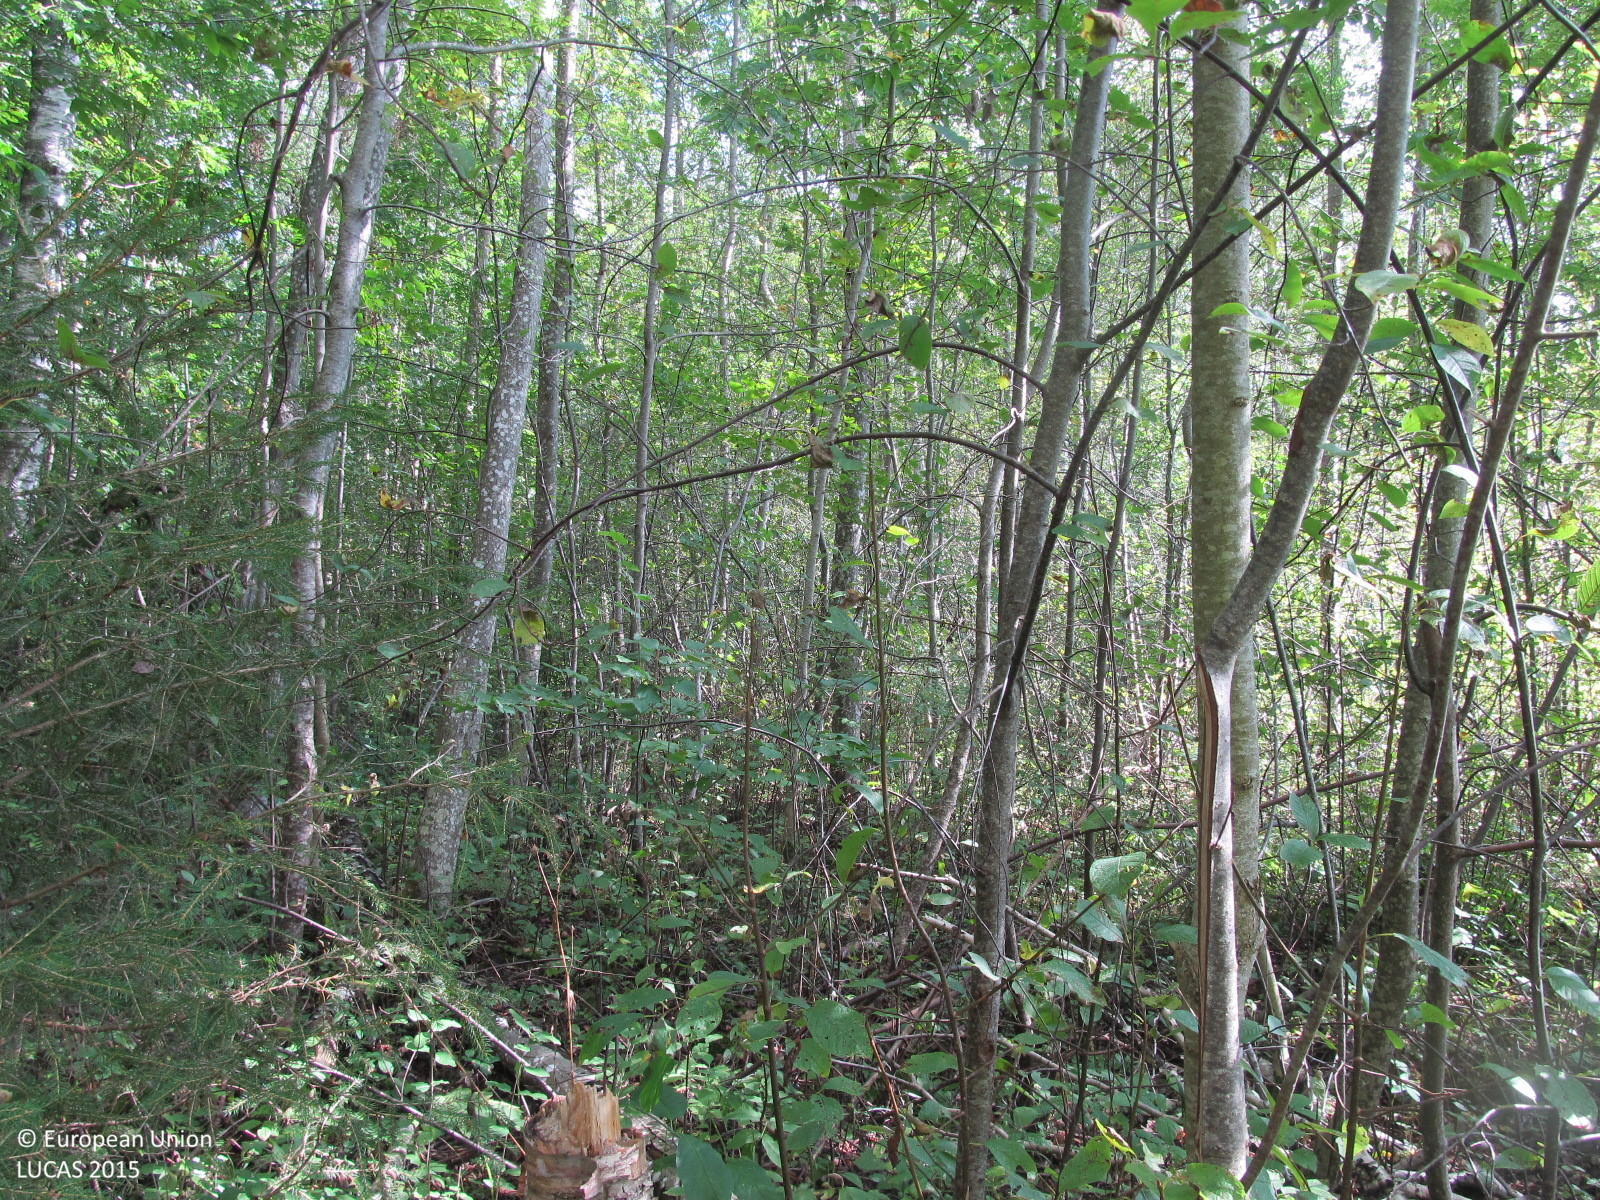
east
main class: Woodland
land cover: Broadleaved woodland
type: non-riverine alder, birch or aspen forest
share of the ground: > 75 %
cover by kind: broadleaved forest trees 75 %, shrubs 10 %, herbaceous plants 10 %, coniferous forest trees 5 %
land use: Forestry
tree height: > 5 m
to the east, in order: Broadleaved woodland; Other mixed woodland; Broadleaved woodland
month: September
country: LT
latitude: 56.0725
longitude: 23.3271
